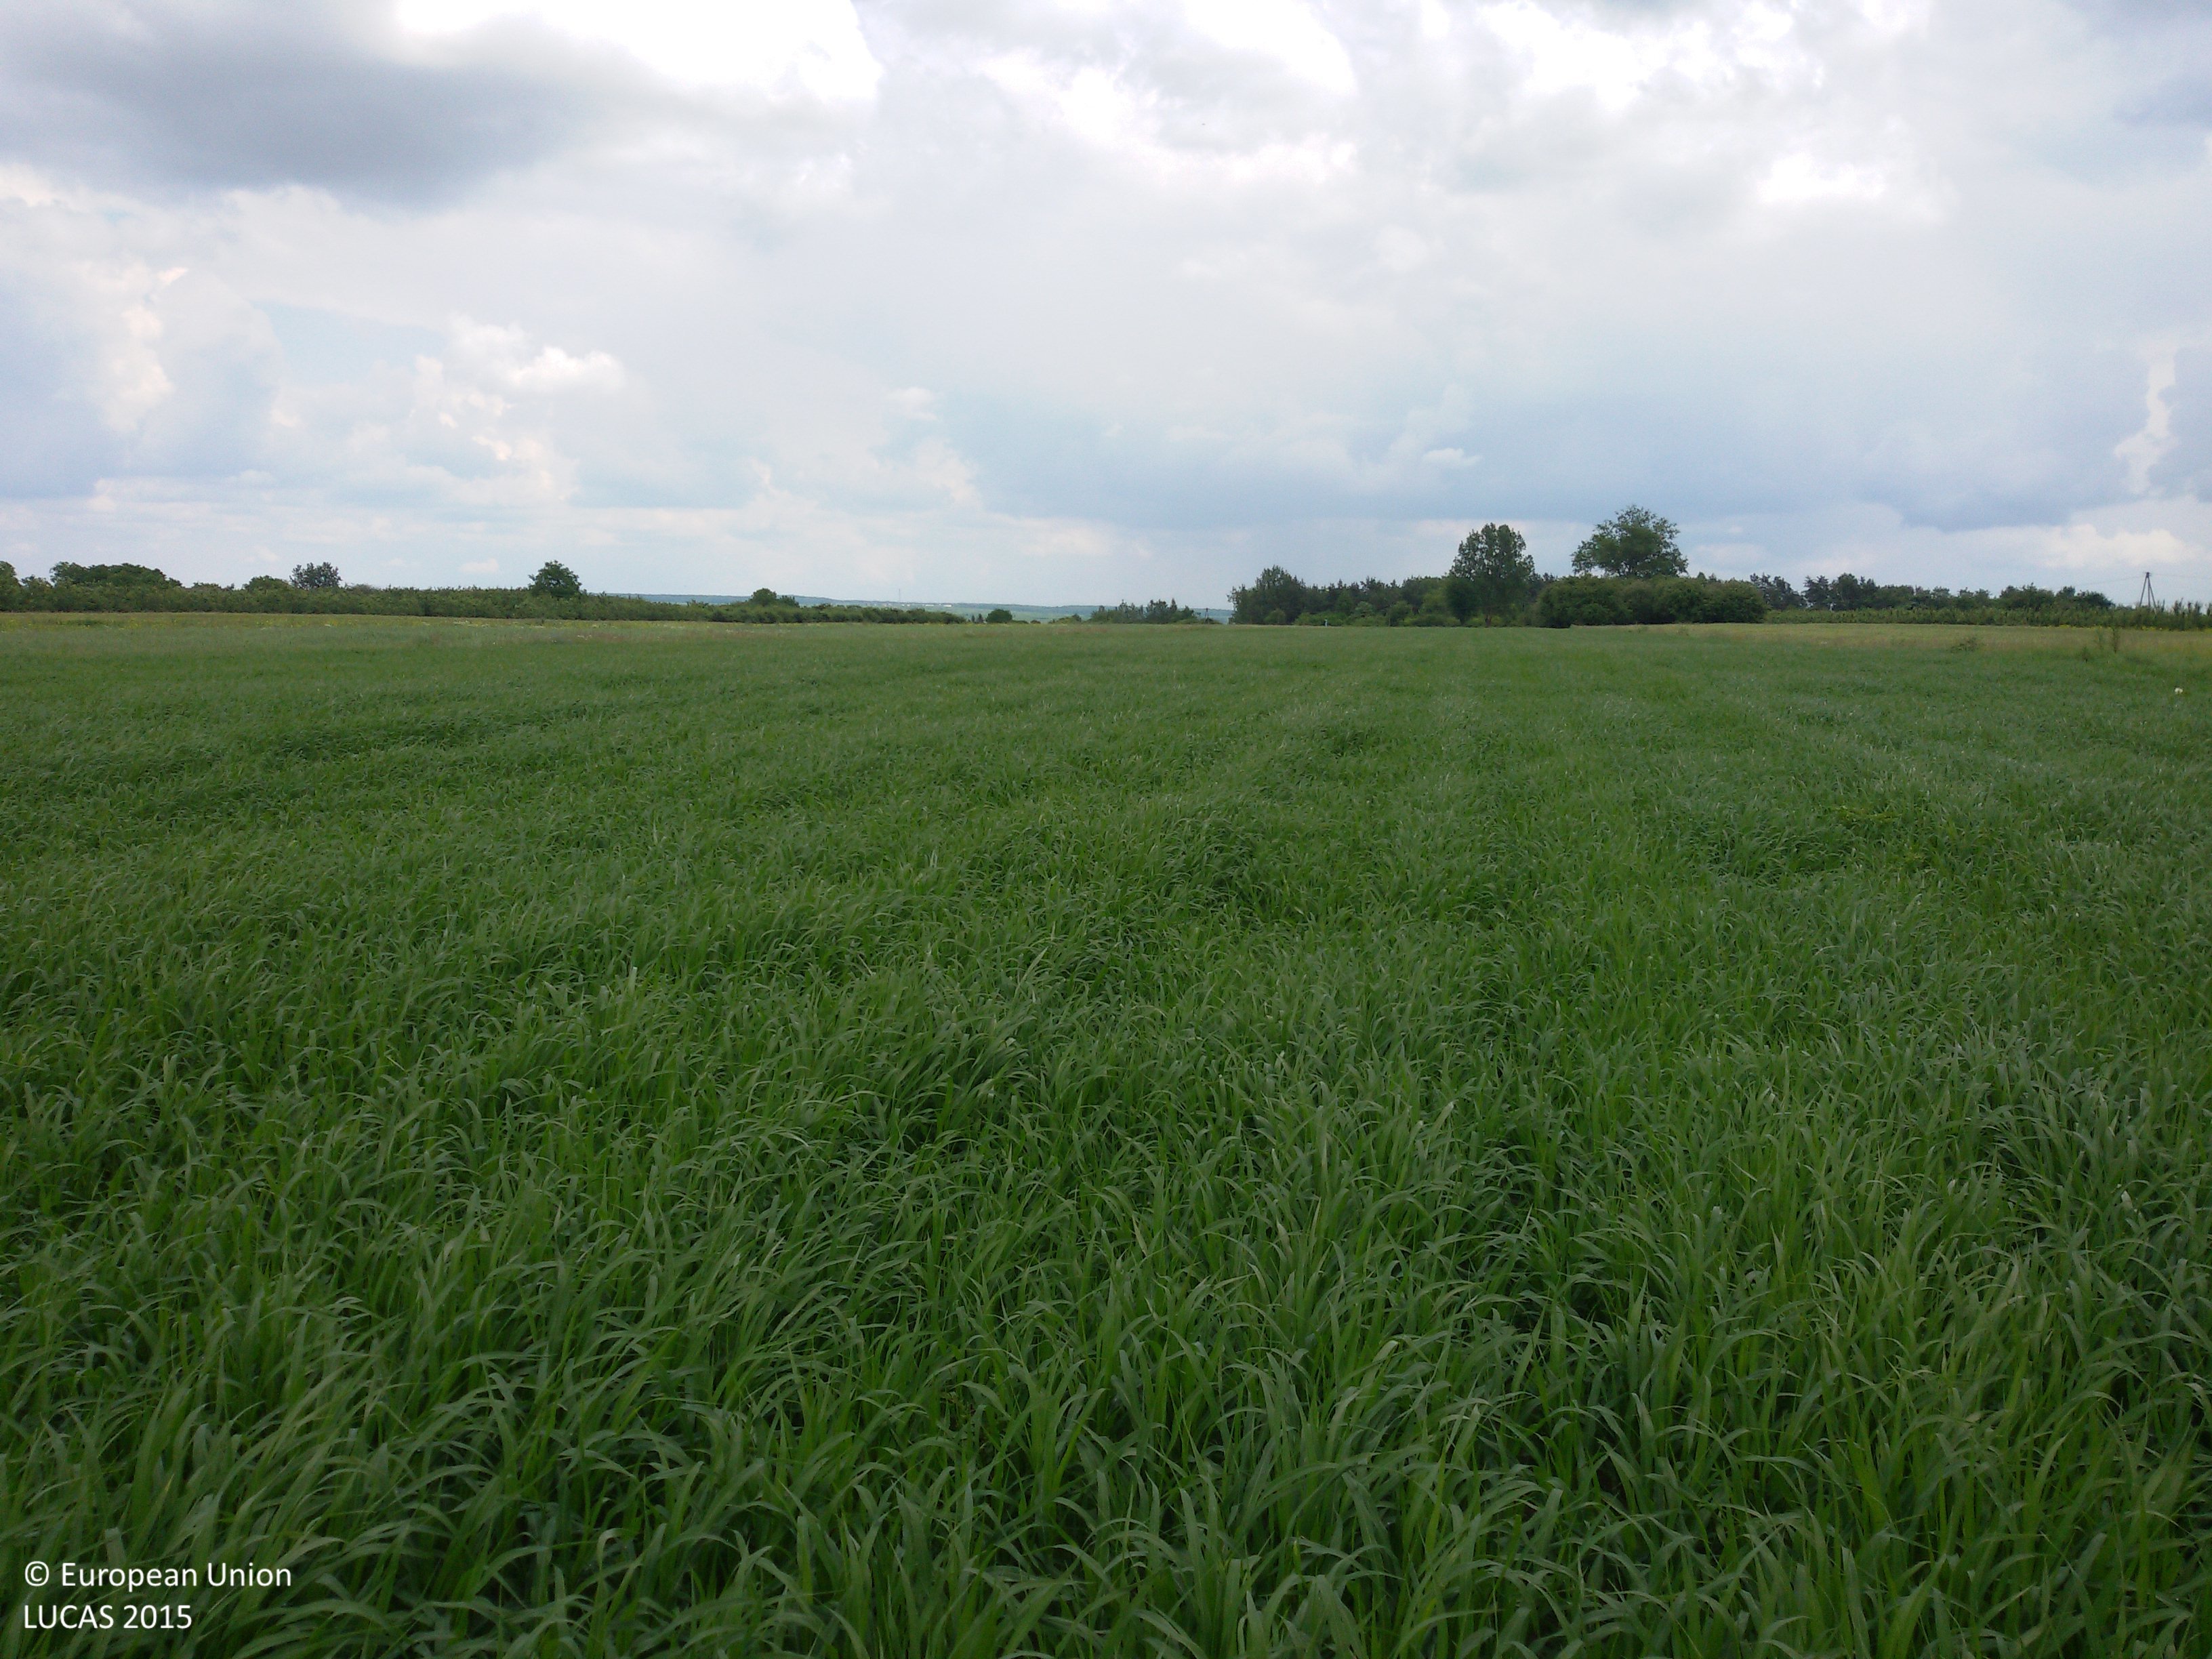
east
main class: Cropland
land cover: Rye
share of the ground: > 75 %
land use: Agriculture (excluding fallow land and kitchen gardens)
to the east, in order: Rye
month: June
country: PL
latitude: 51.0271
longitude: 21.7606
